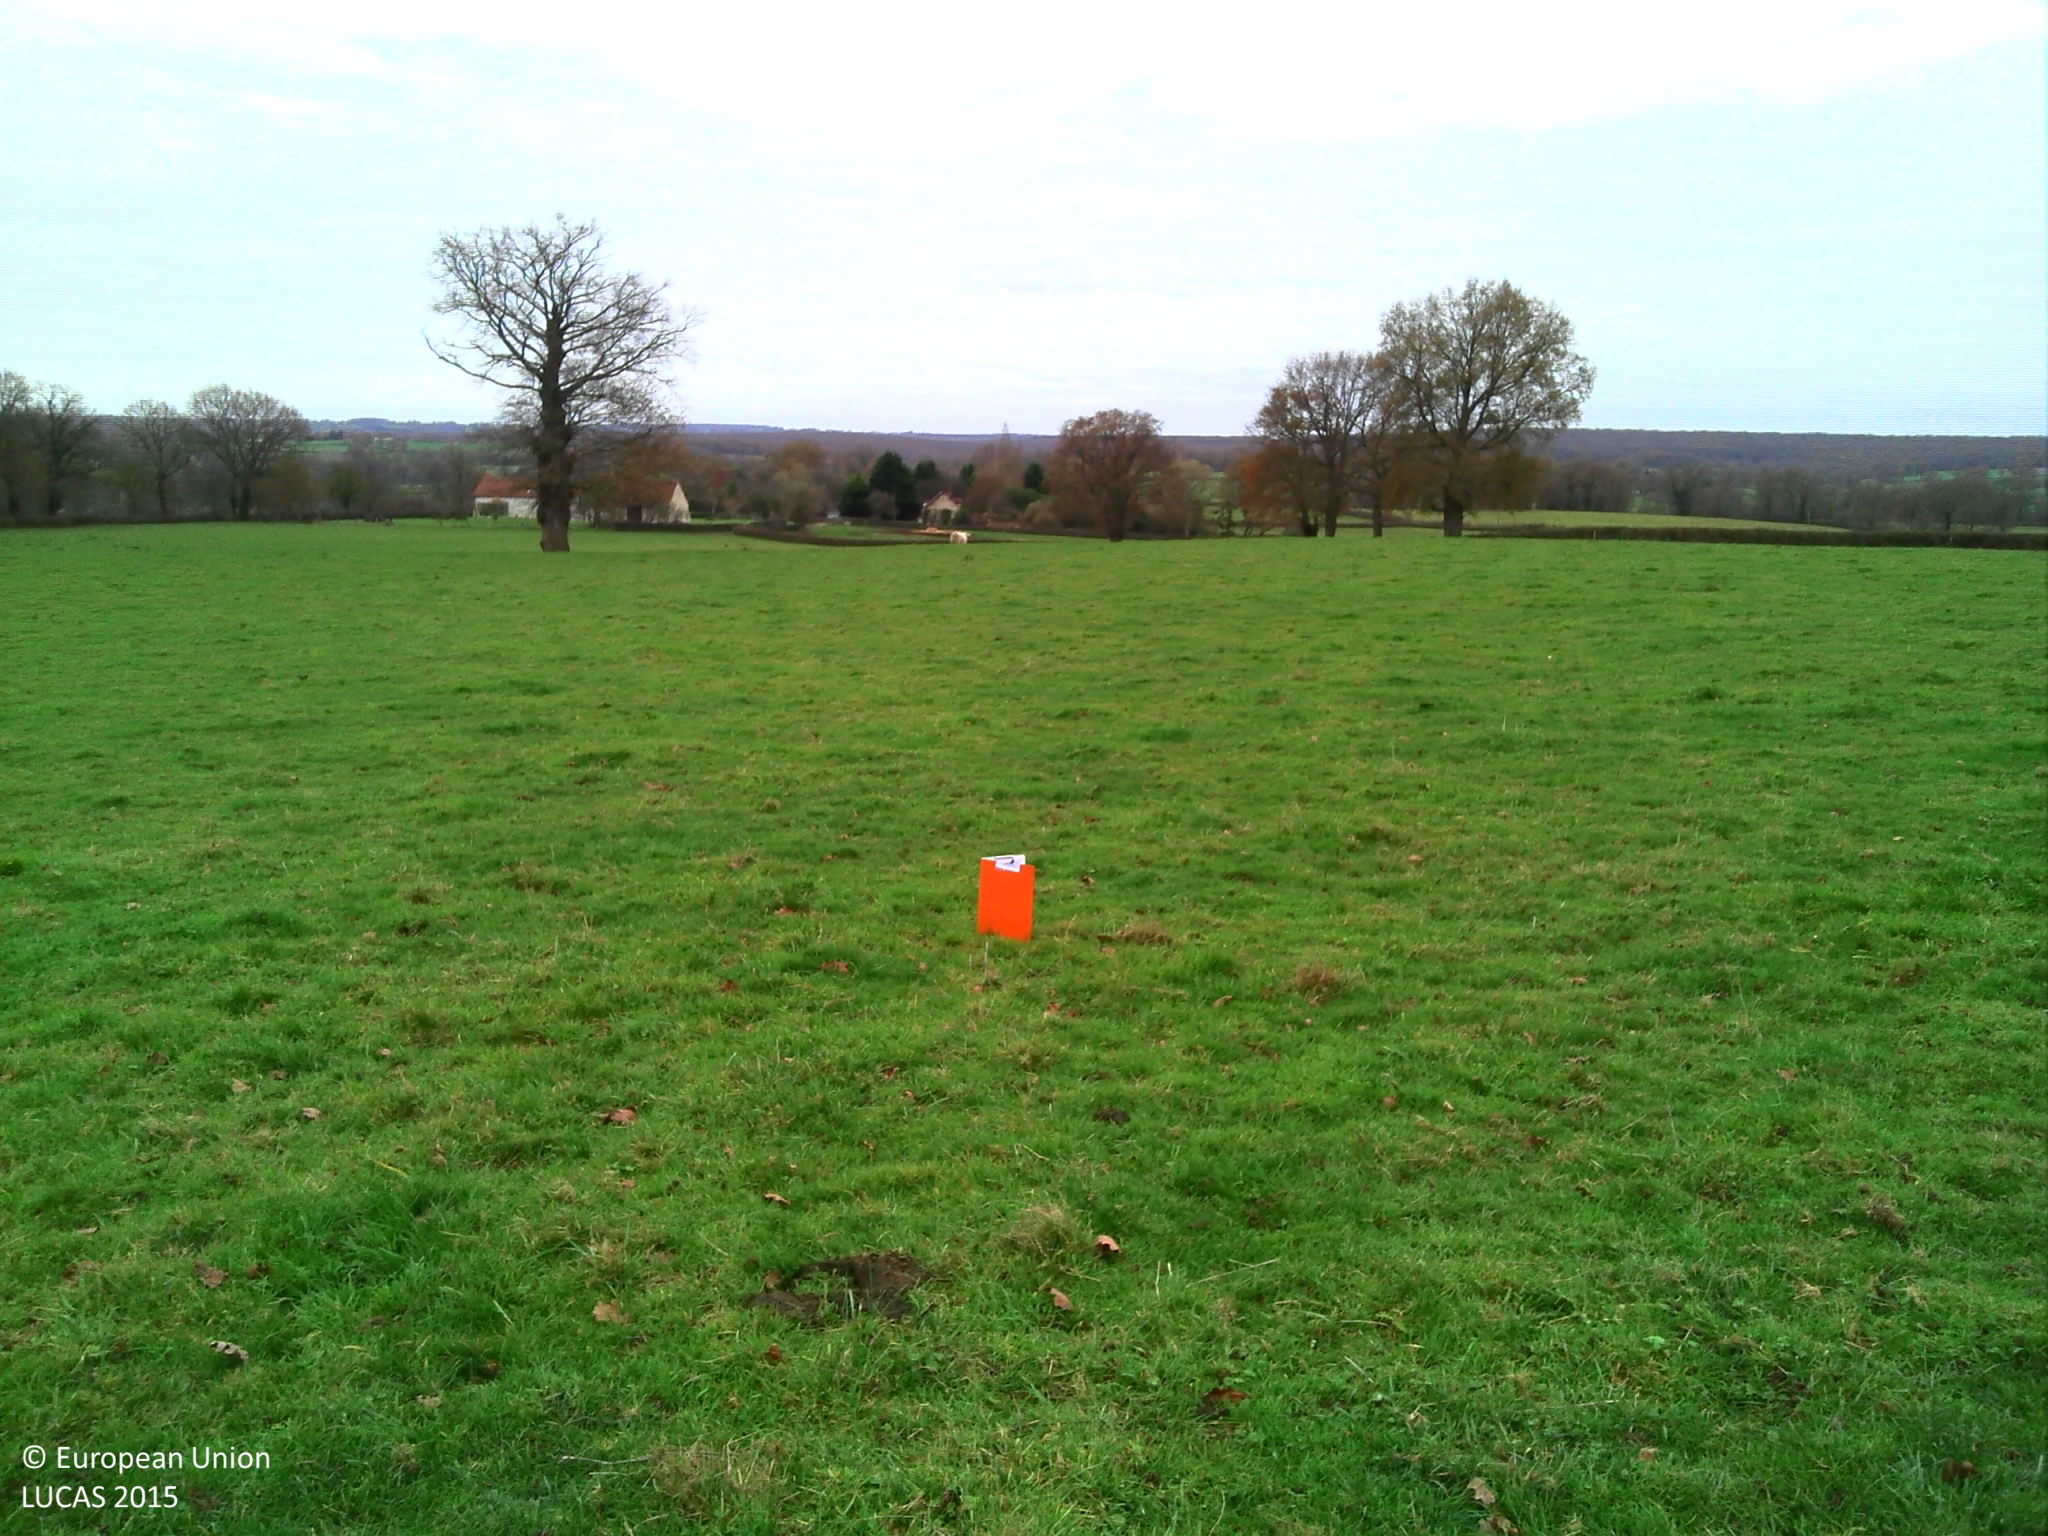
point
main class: Grassland
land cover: Grassland without tree/shrub cover
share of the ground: > 75 %
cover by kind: herbaceous plants 100 %
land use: Agriculture (excluding fallow land and kitchen gardens)
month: July
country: FR
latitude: 46.5355
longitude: 2.9690
